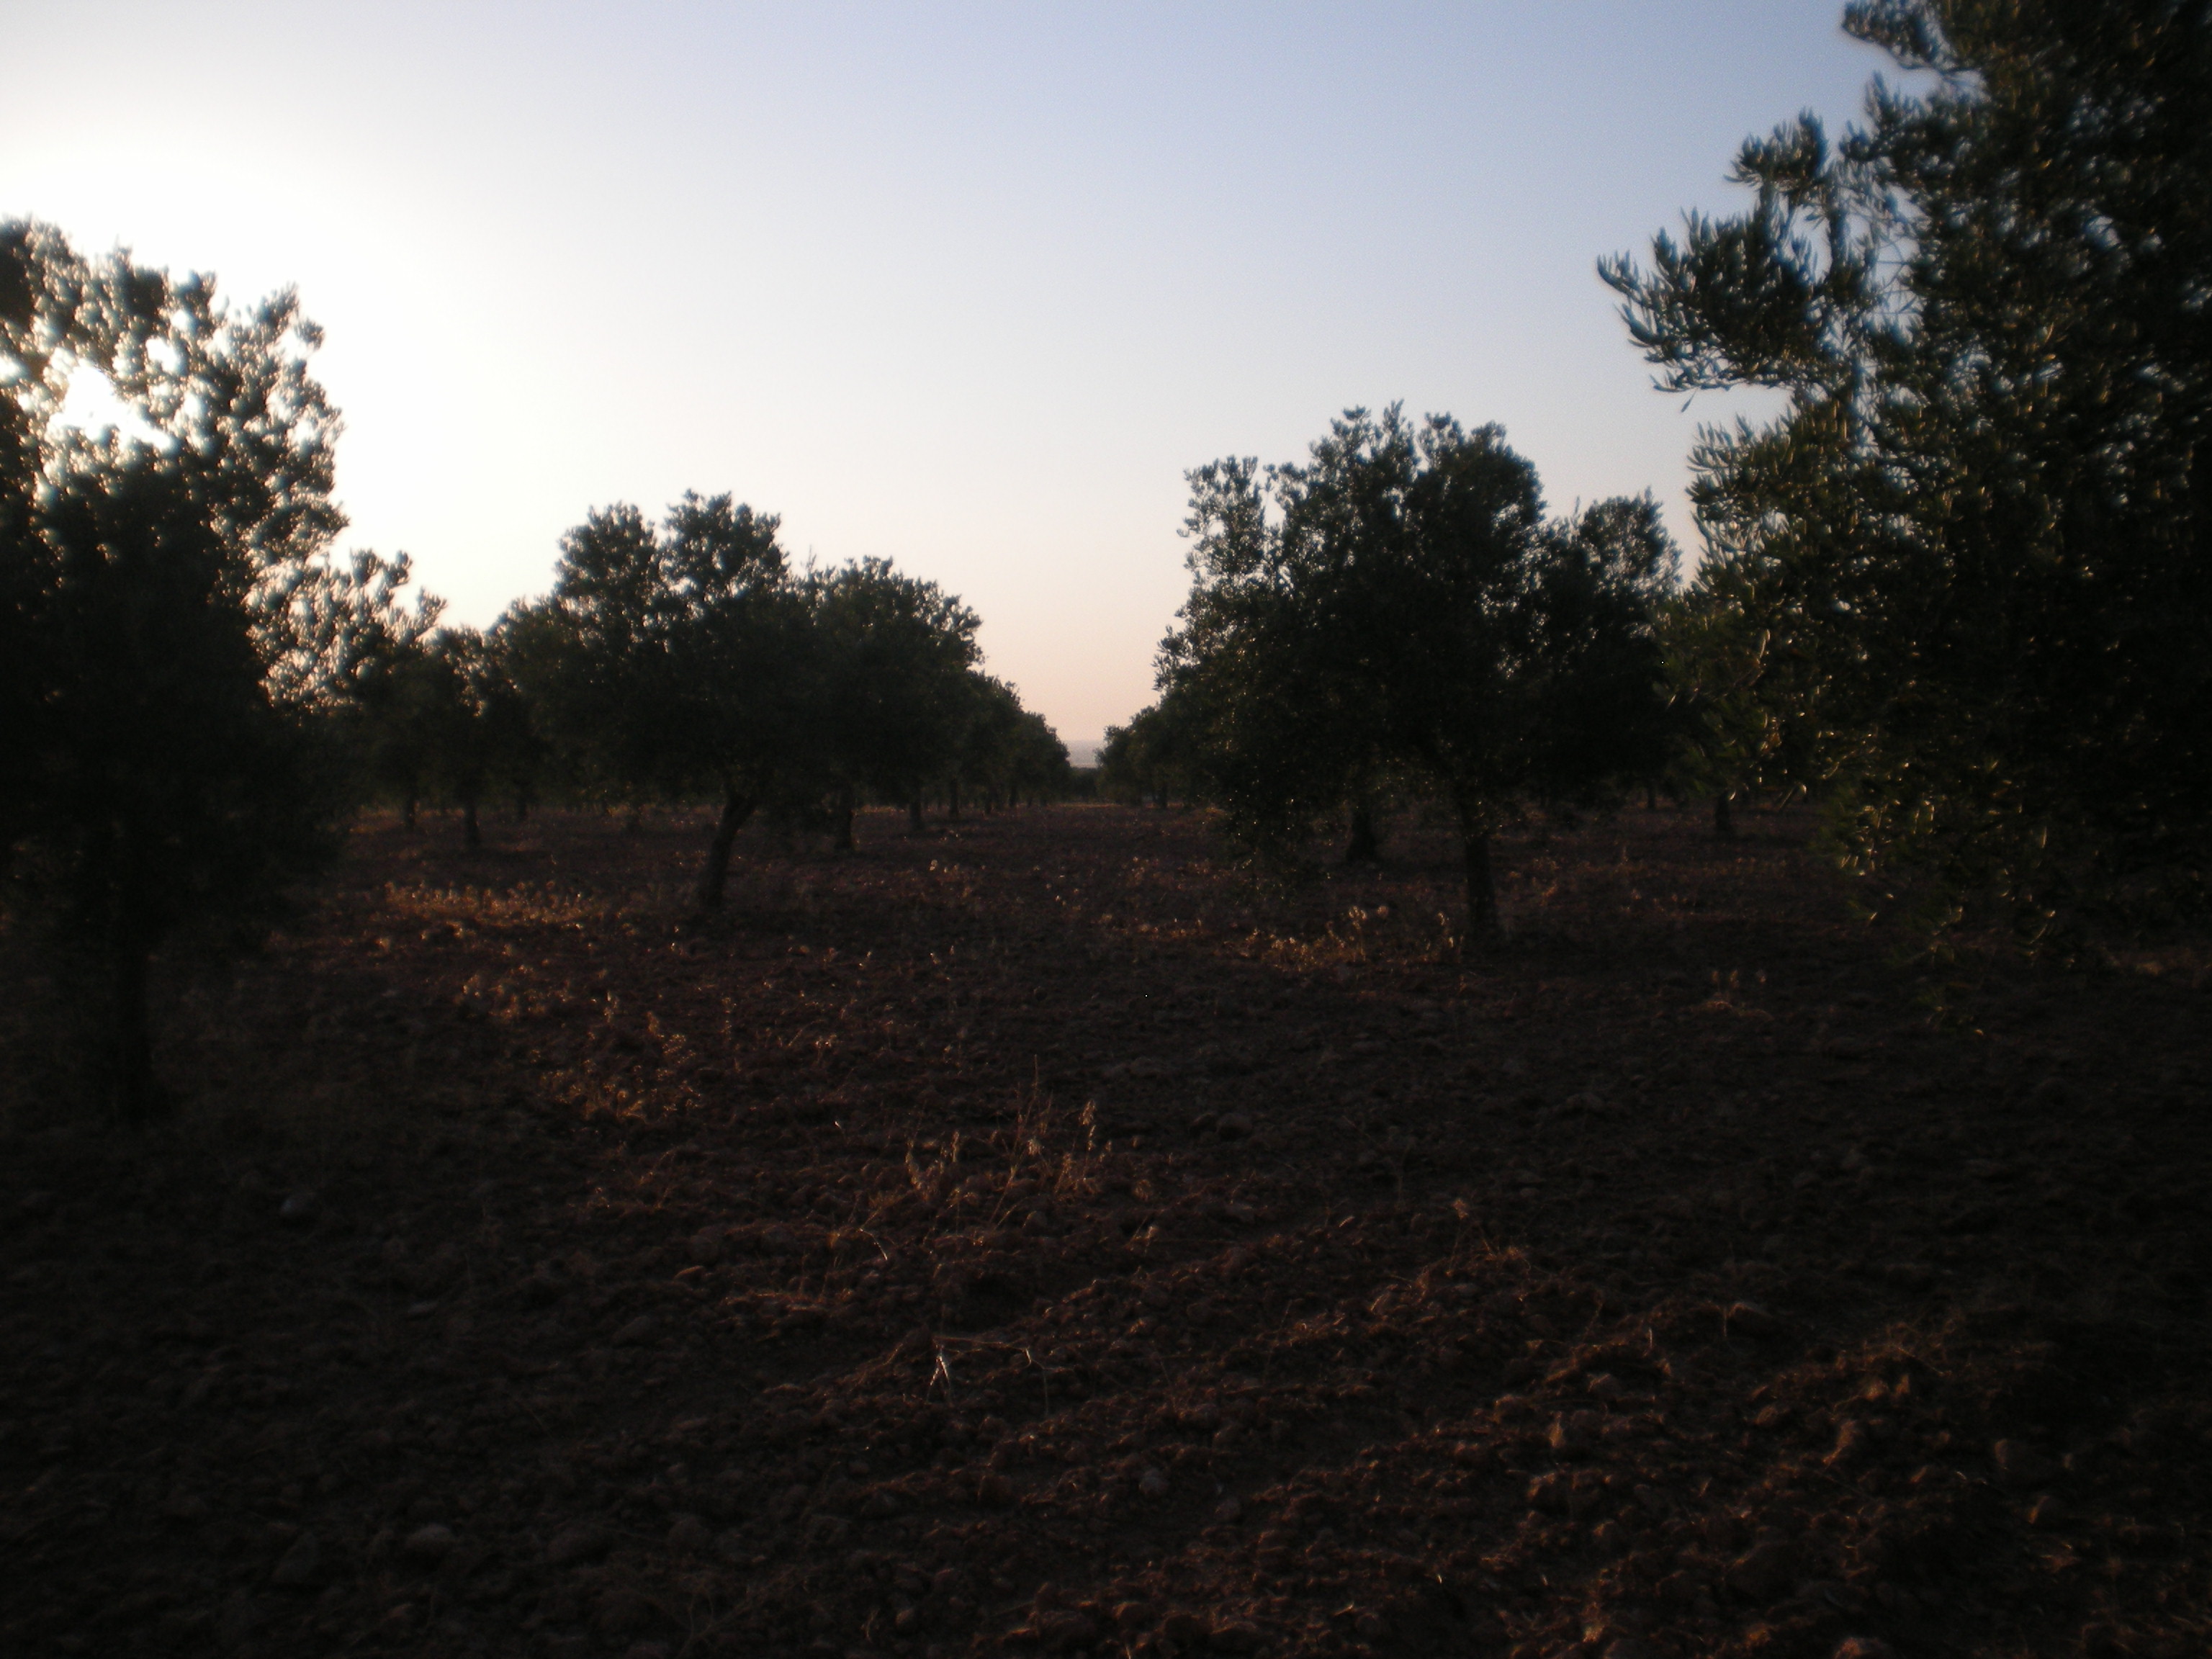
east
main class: Cropland
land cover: Olive groves
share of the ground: 10 - 25 %
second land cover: Other bare soil
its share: > 75 %
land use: Agriculture (excluding fallow land and kitchen gardens)
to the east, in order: Olive groves; Other bare soil; Grass margins; Tracks; Grass margins; Olive groves
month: July
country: ES
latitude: 39.4444
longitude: -3.0659
